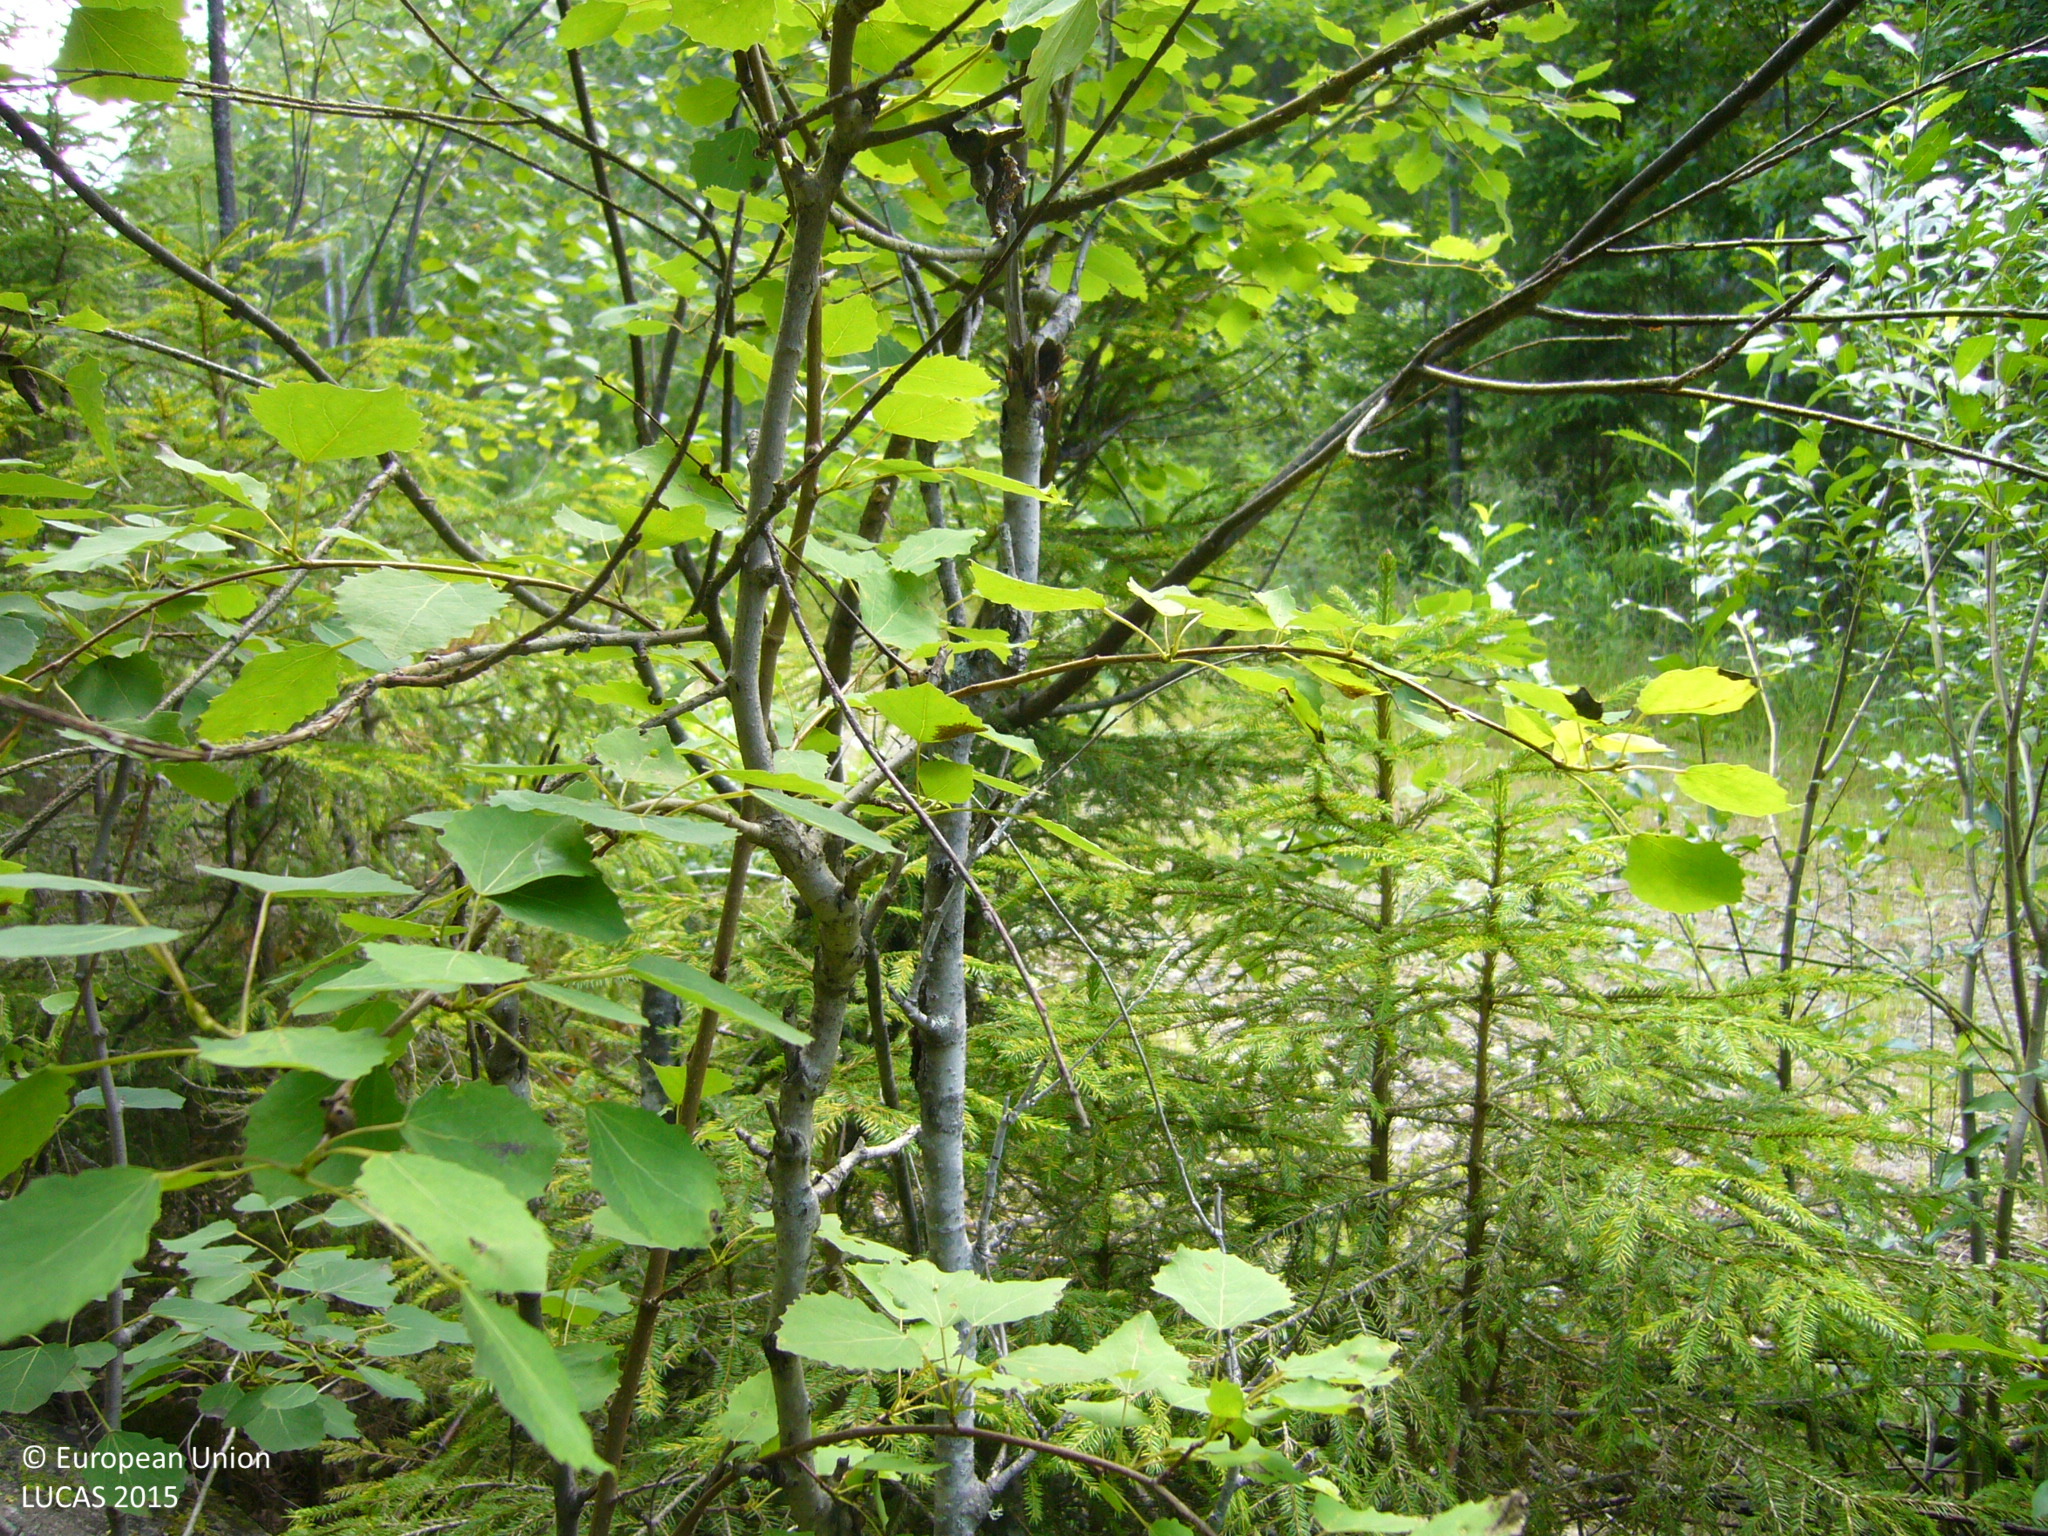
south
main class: Woodland
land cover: Other mixed woodland
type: boreal forest
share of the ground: > 75 %
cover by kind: broadleaved forest trees 60 %, coniferous forest trees 25 %, shrubs 15 %
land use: Forestry
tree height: > 5 m
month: July
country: FI
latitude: 63.9735
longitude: 25.9371
